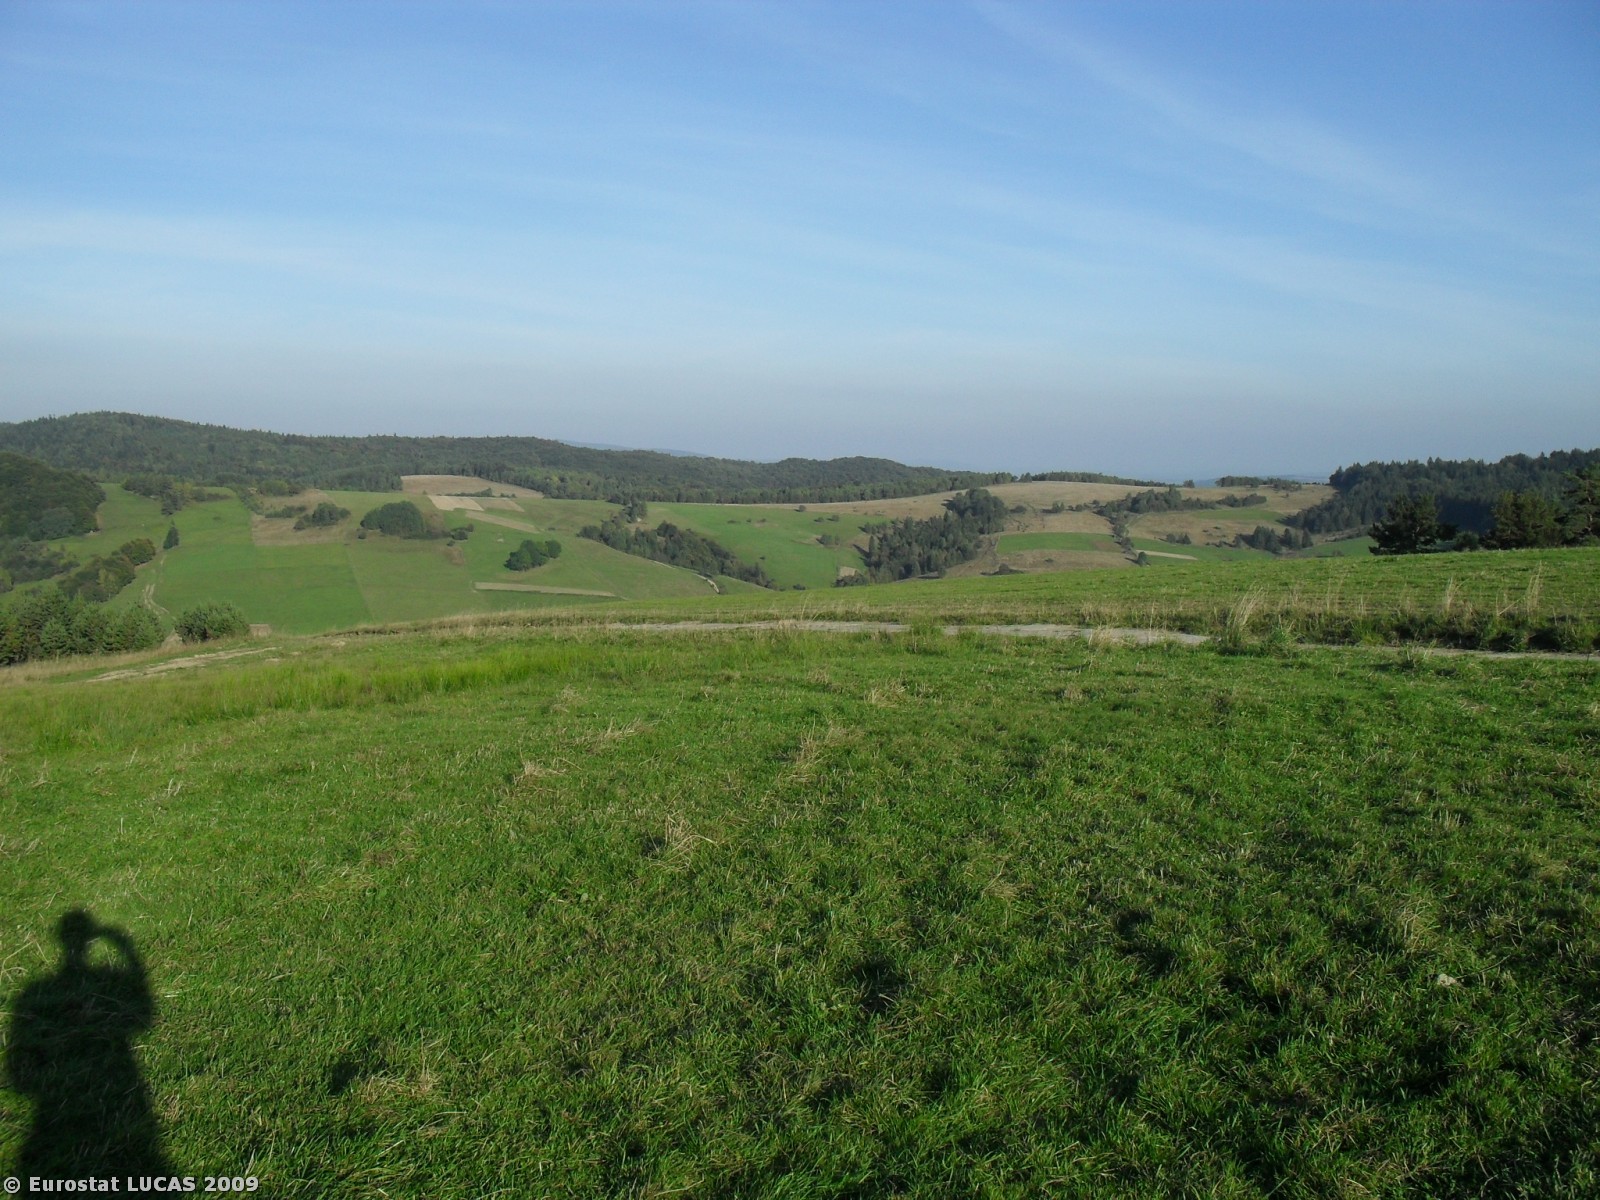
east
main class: Grassland
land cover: Grassland without tree/shrub cover
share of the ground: > 75 %
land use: Agriculture (excluding fallow land and kitchen gardens)
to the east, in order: Grassland without tree/shrub cover; Tracks; Grassland without tree/shrub cover
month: September
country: PL
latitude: 49.3431
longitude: 20.9847
